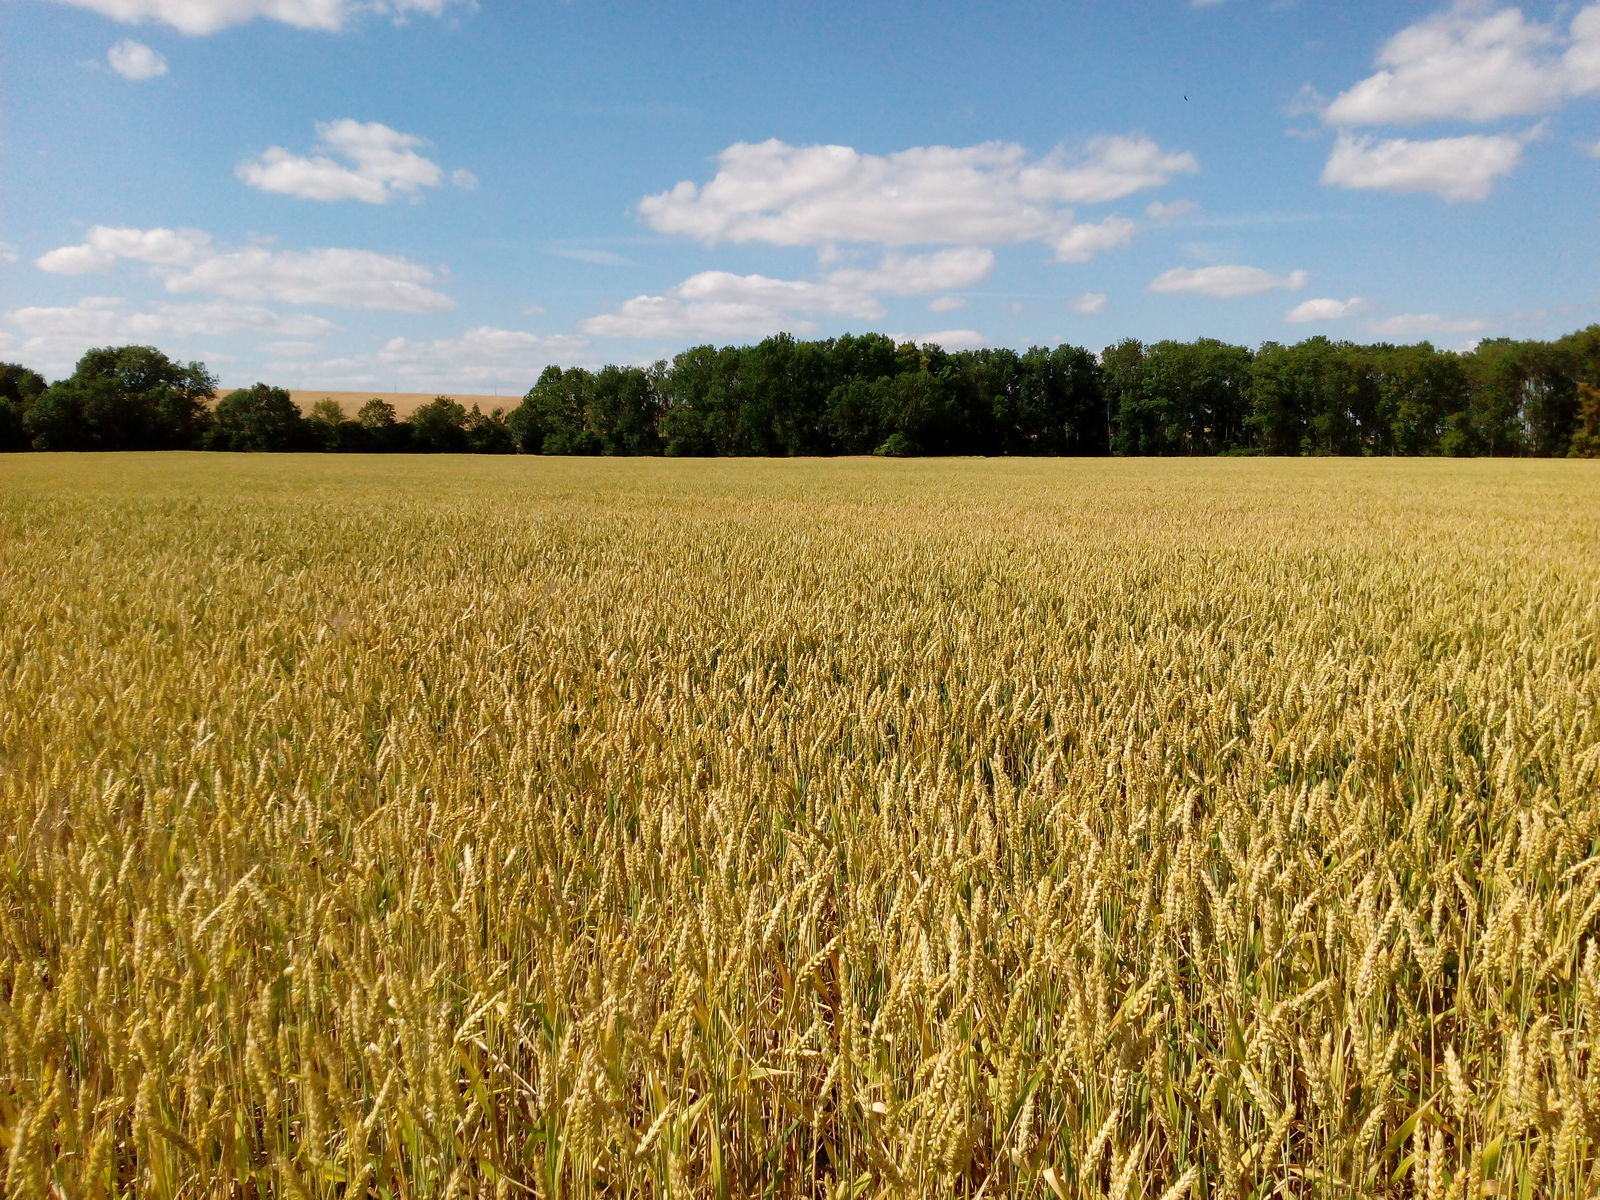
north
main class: Cropland
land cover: Common wheat
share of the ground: > 75 %
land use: Agriculture (excluding fallow land and kitchen gardens)
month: July
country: DE
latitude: 51.1140
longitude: 11.0996
